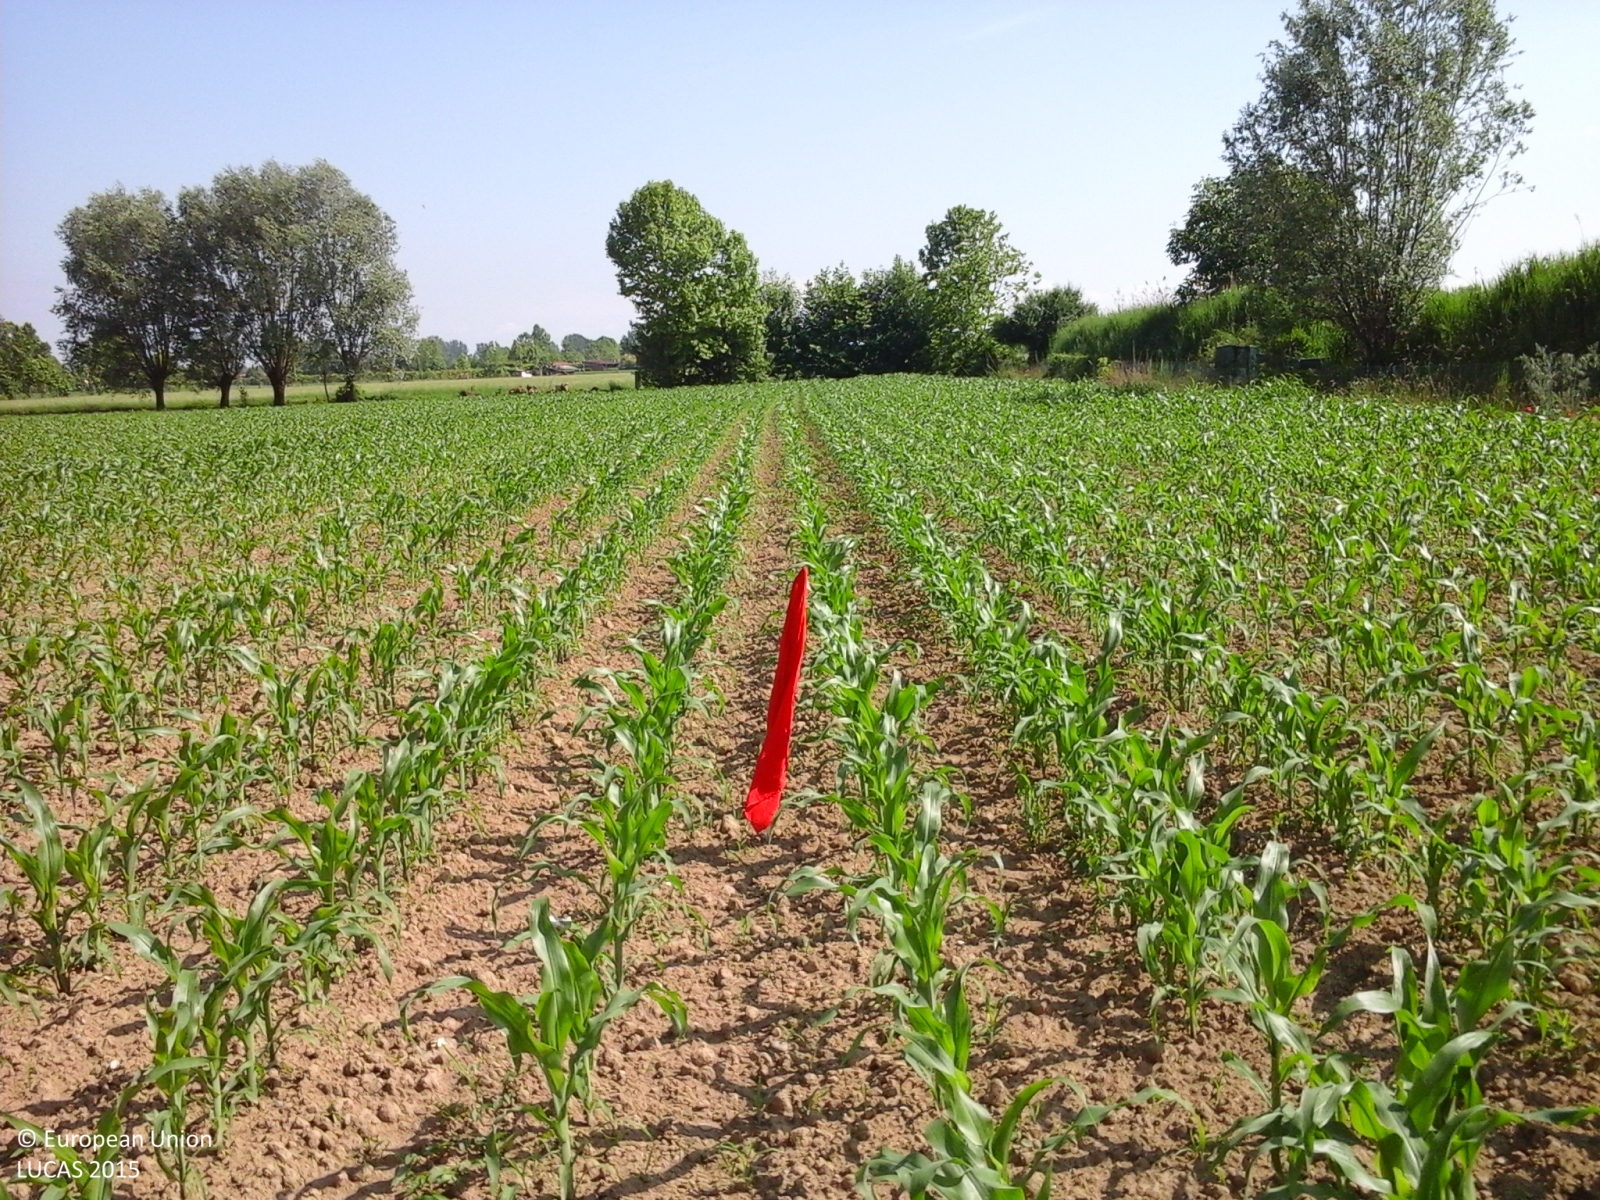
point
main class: Cropland
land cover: Maize
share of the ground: 10 - 25 %
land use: Agriculture (excluding fallow land and kitchen gardens)
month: May
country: IT
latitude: 45.4679
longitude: 9.6808
